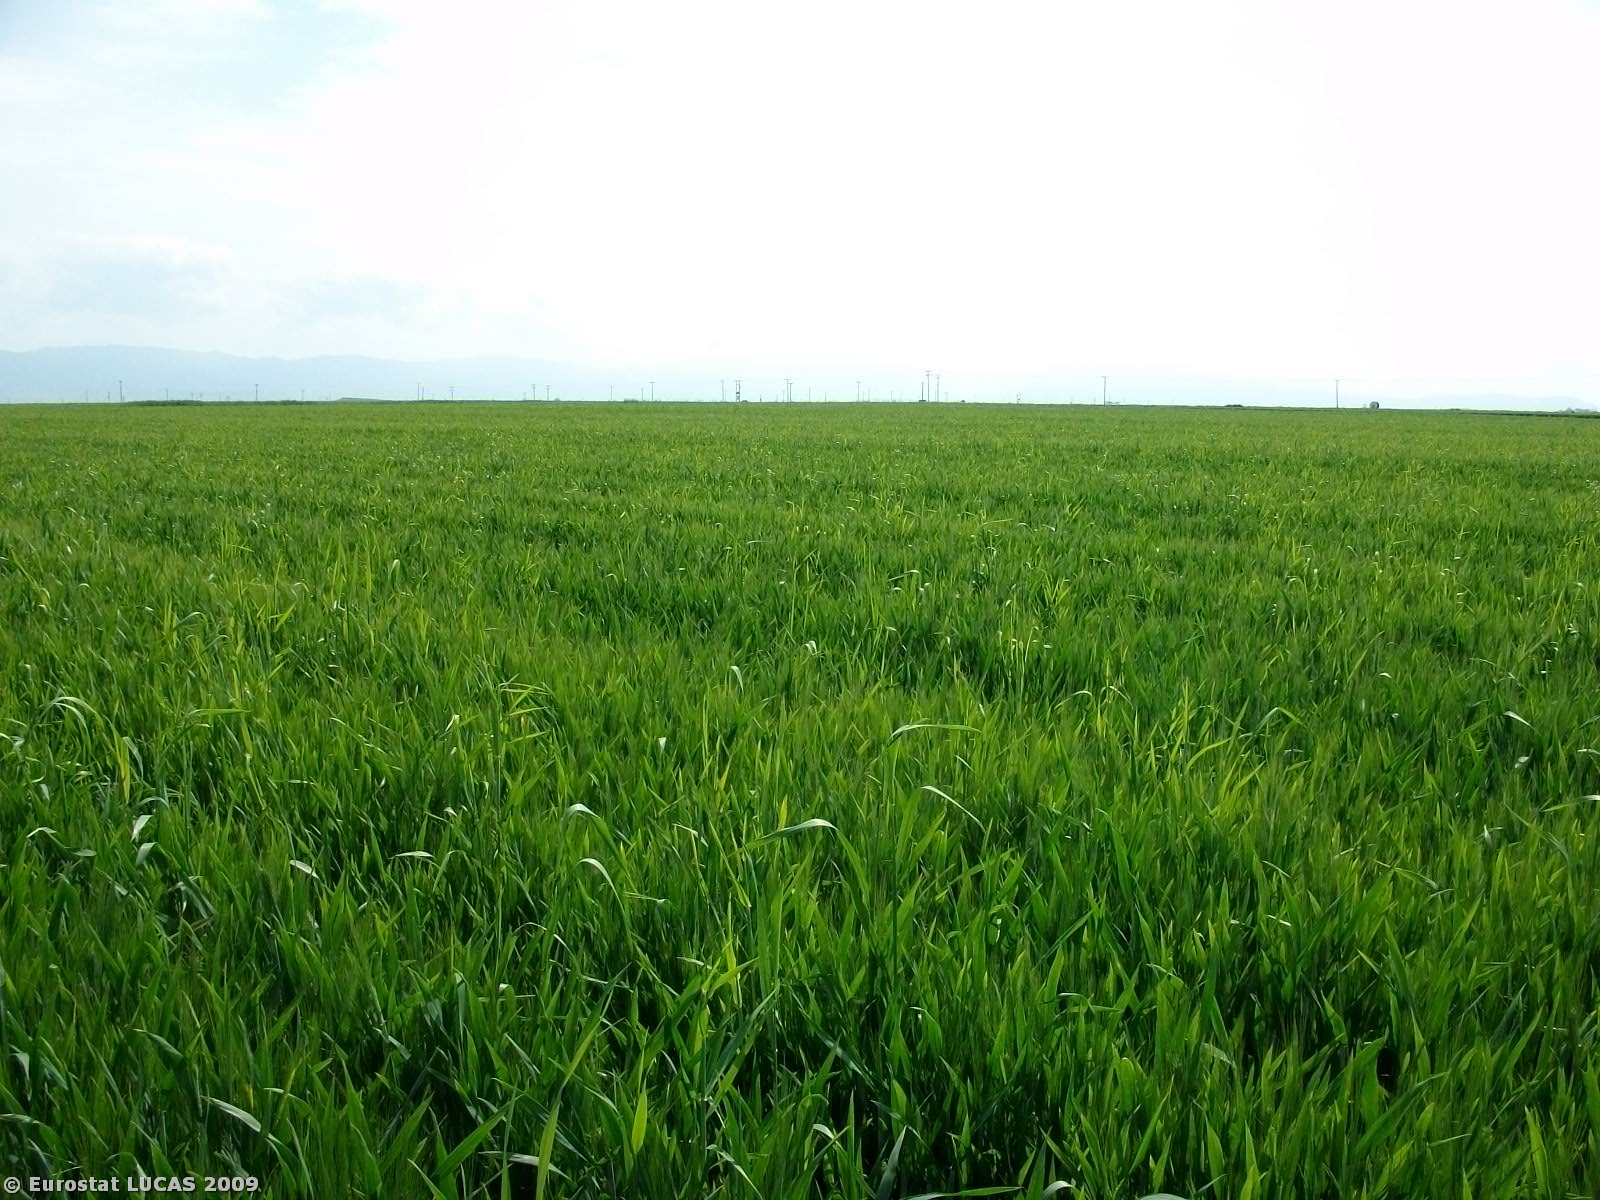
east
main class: Cropland
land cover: Durum wheat
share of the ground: > 75 %
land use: Agriculture (excluding fallow land and kitchen gardens)
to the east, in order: Durum wheat; Tomatoes; Paved roads, cycling and walking lanes; Durum wheat
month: April
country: GR
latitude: 39.5291
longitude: 22.5660
